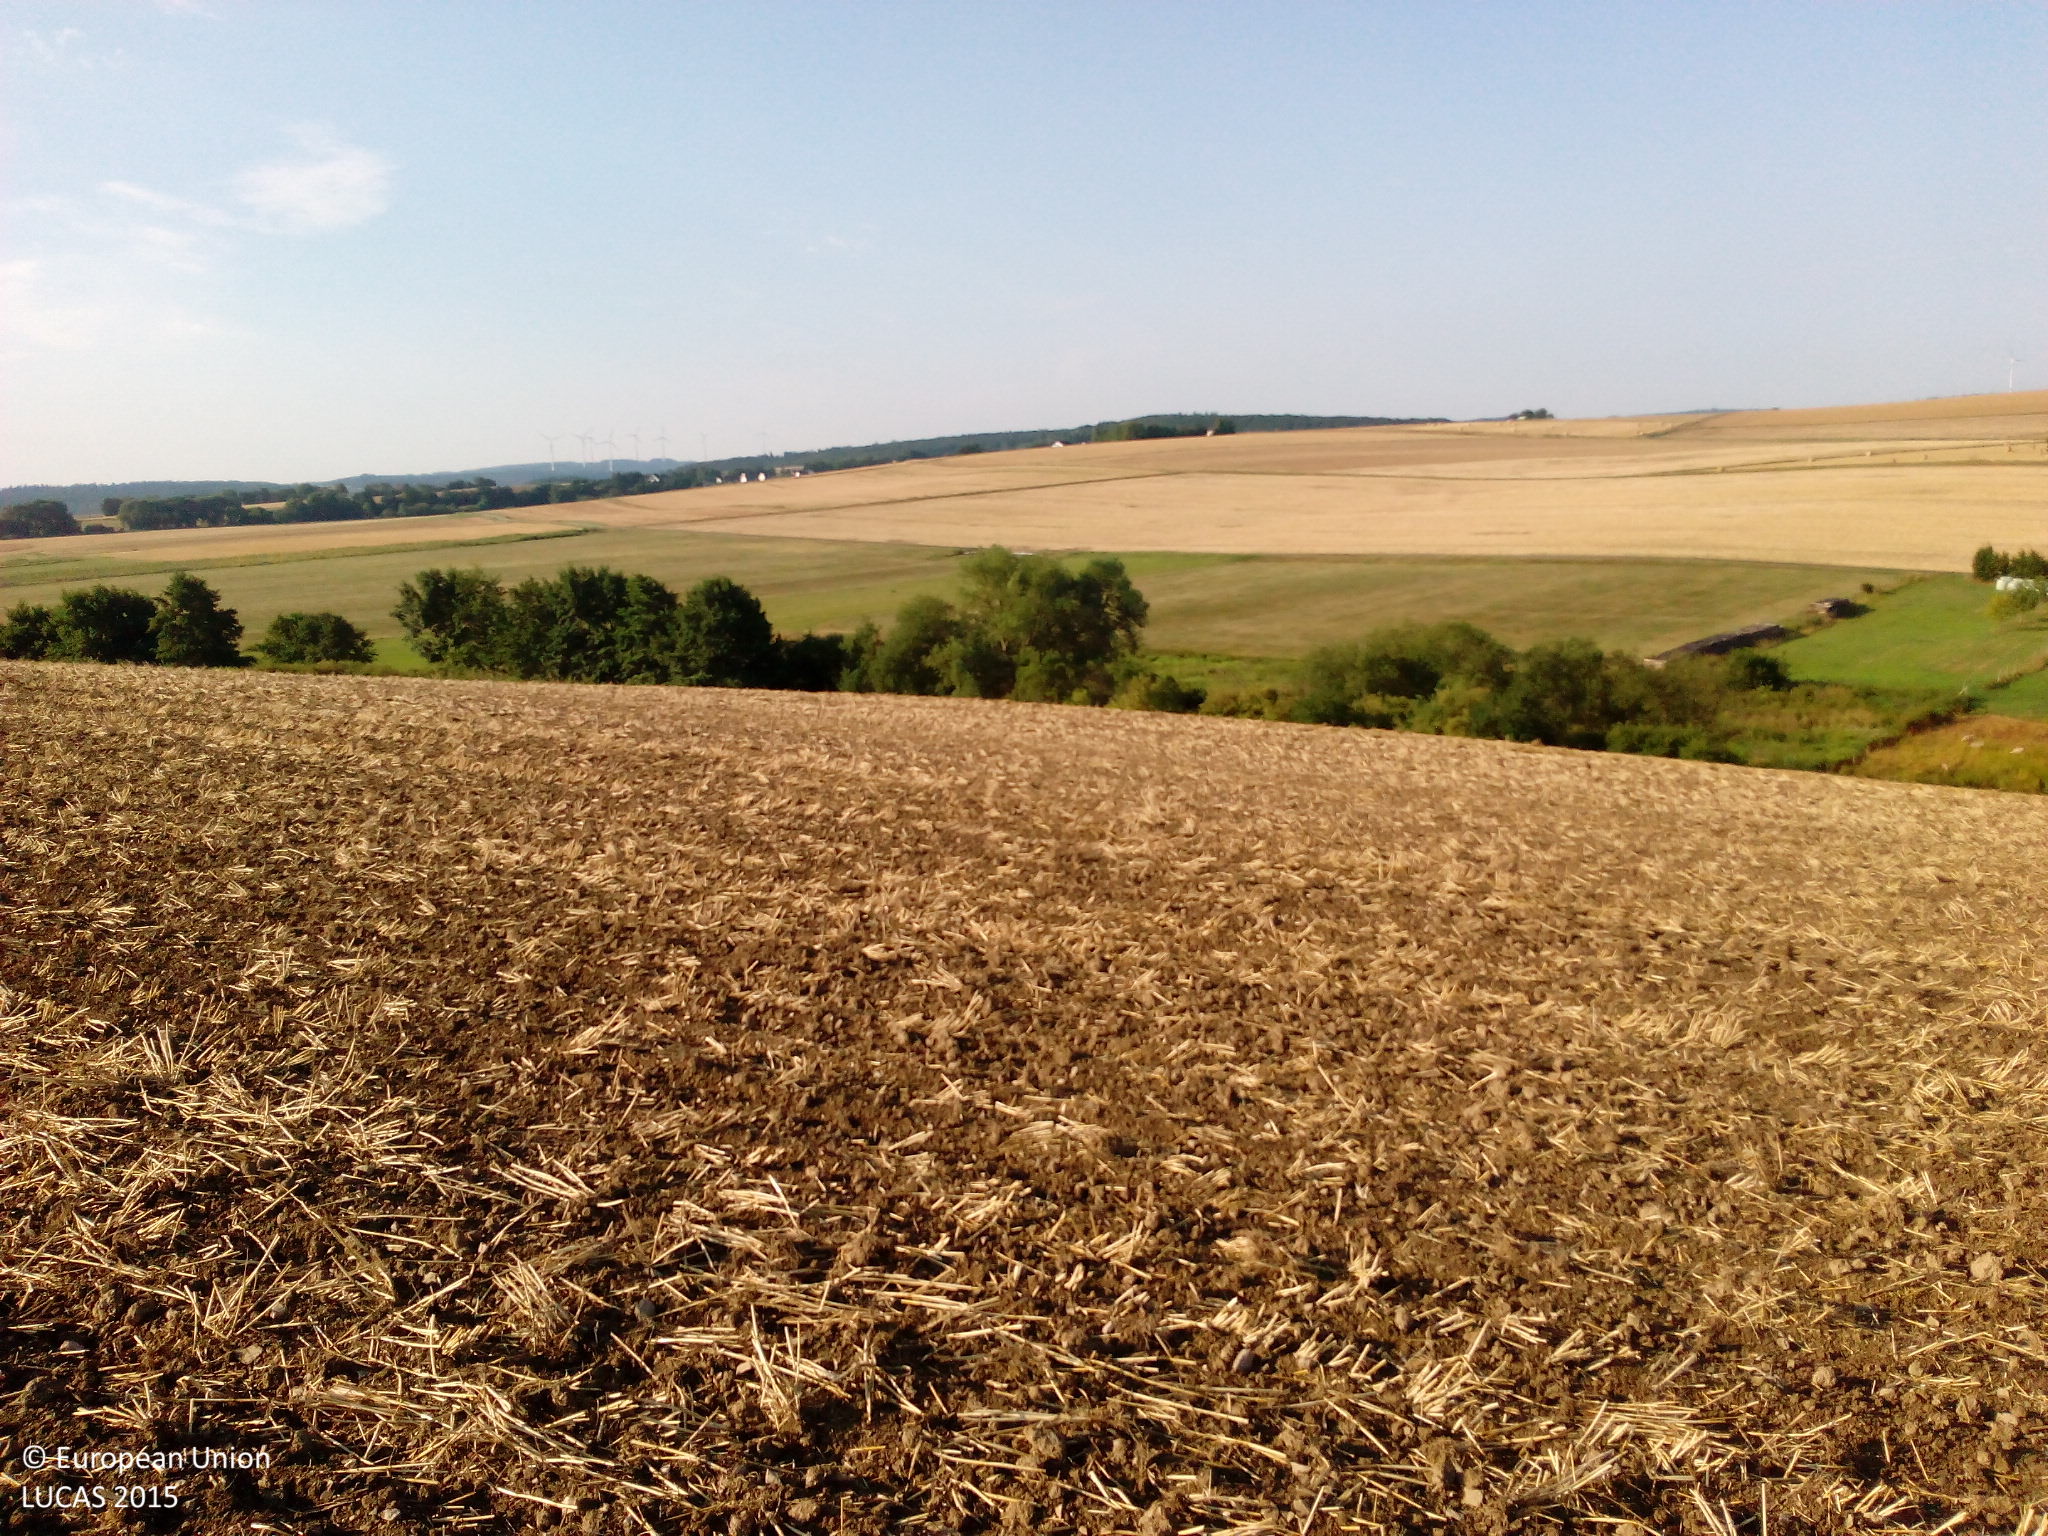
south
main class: Cropland
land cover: Common wheat
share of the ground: < 10 %
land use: Agriculture (excluding fallow land and kitchen gardens)
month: August
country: DE
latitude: 50.2391
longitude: 8.0234
